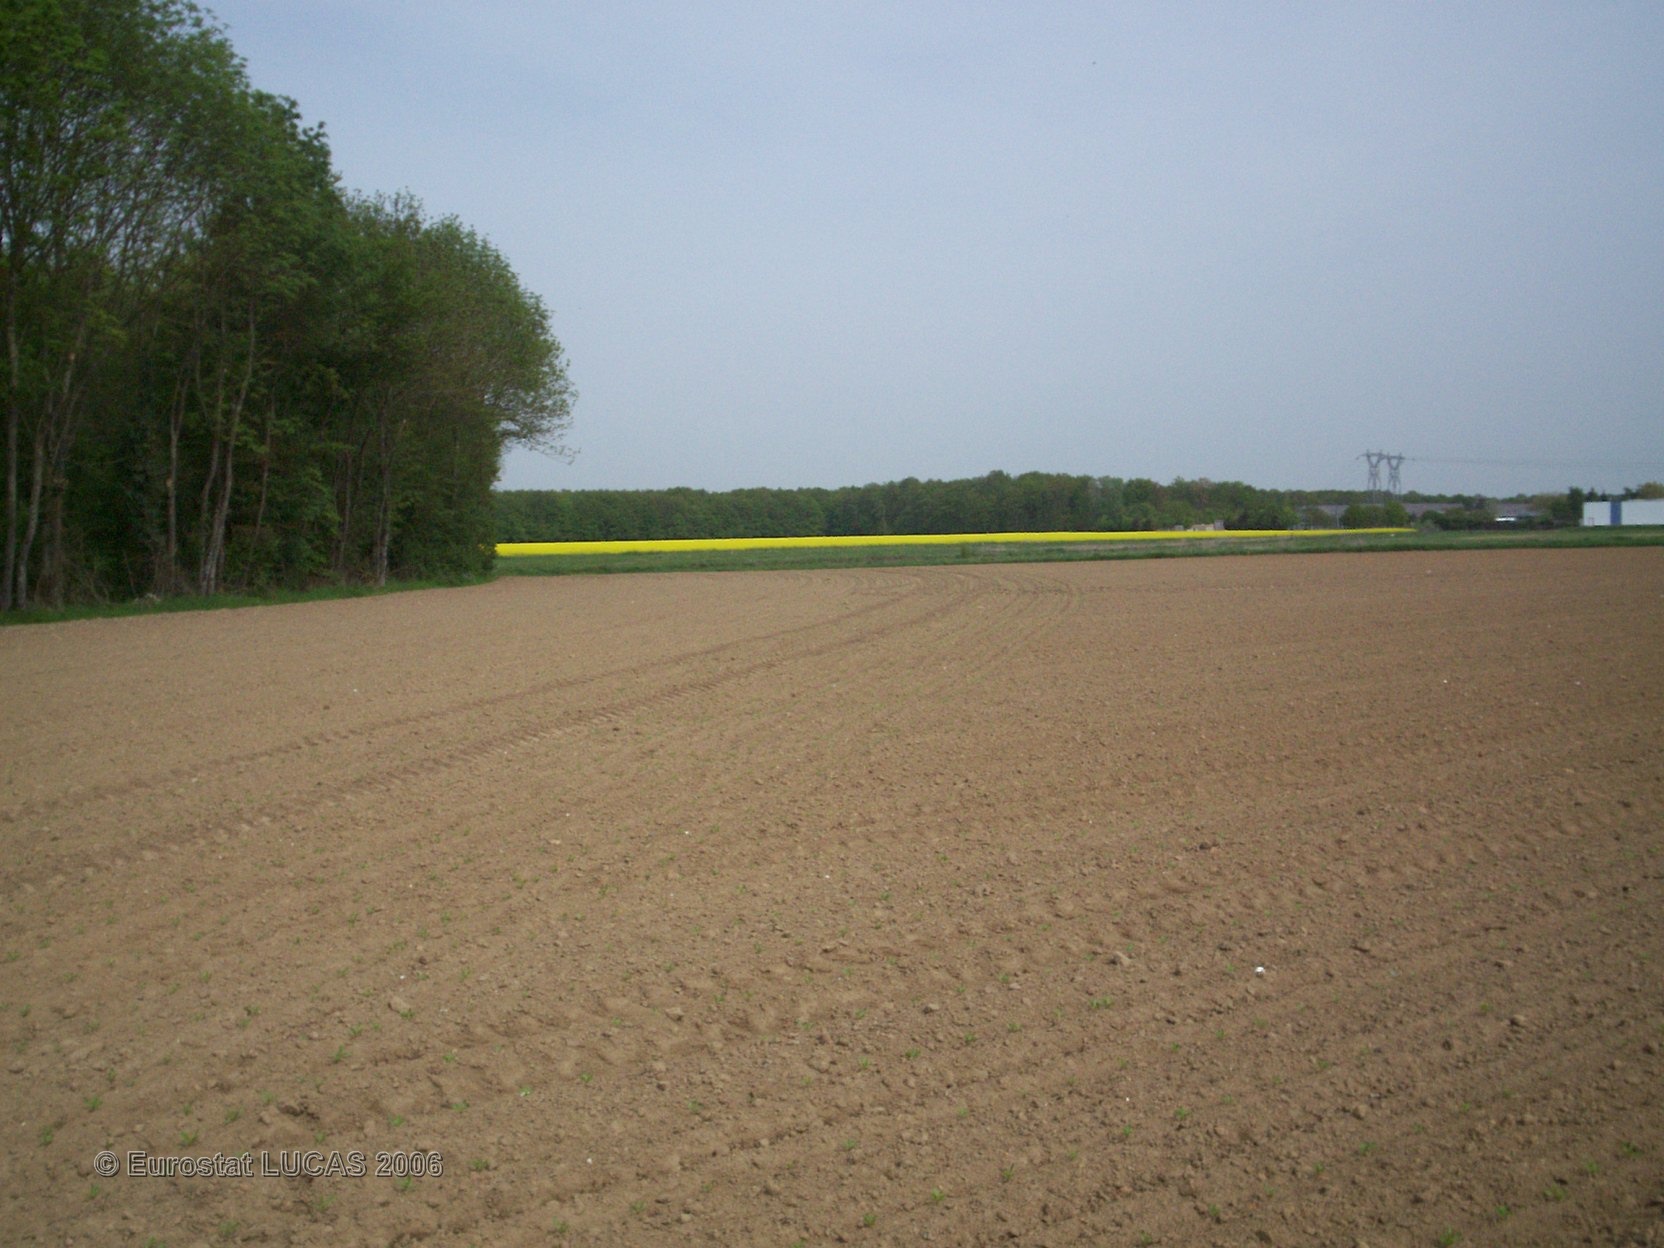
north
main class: Cropland
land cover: Sugar beet
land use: Agriculture (excluding fallow land and kitchen gardens)
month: May
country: FR
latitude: 48.6390
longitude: 2.8117
